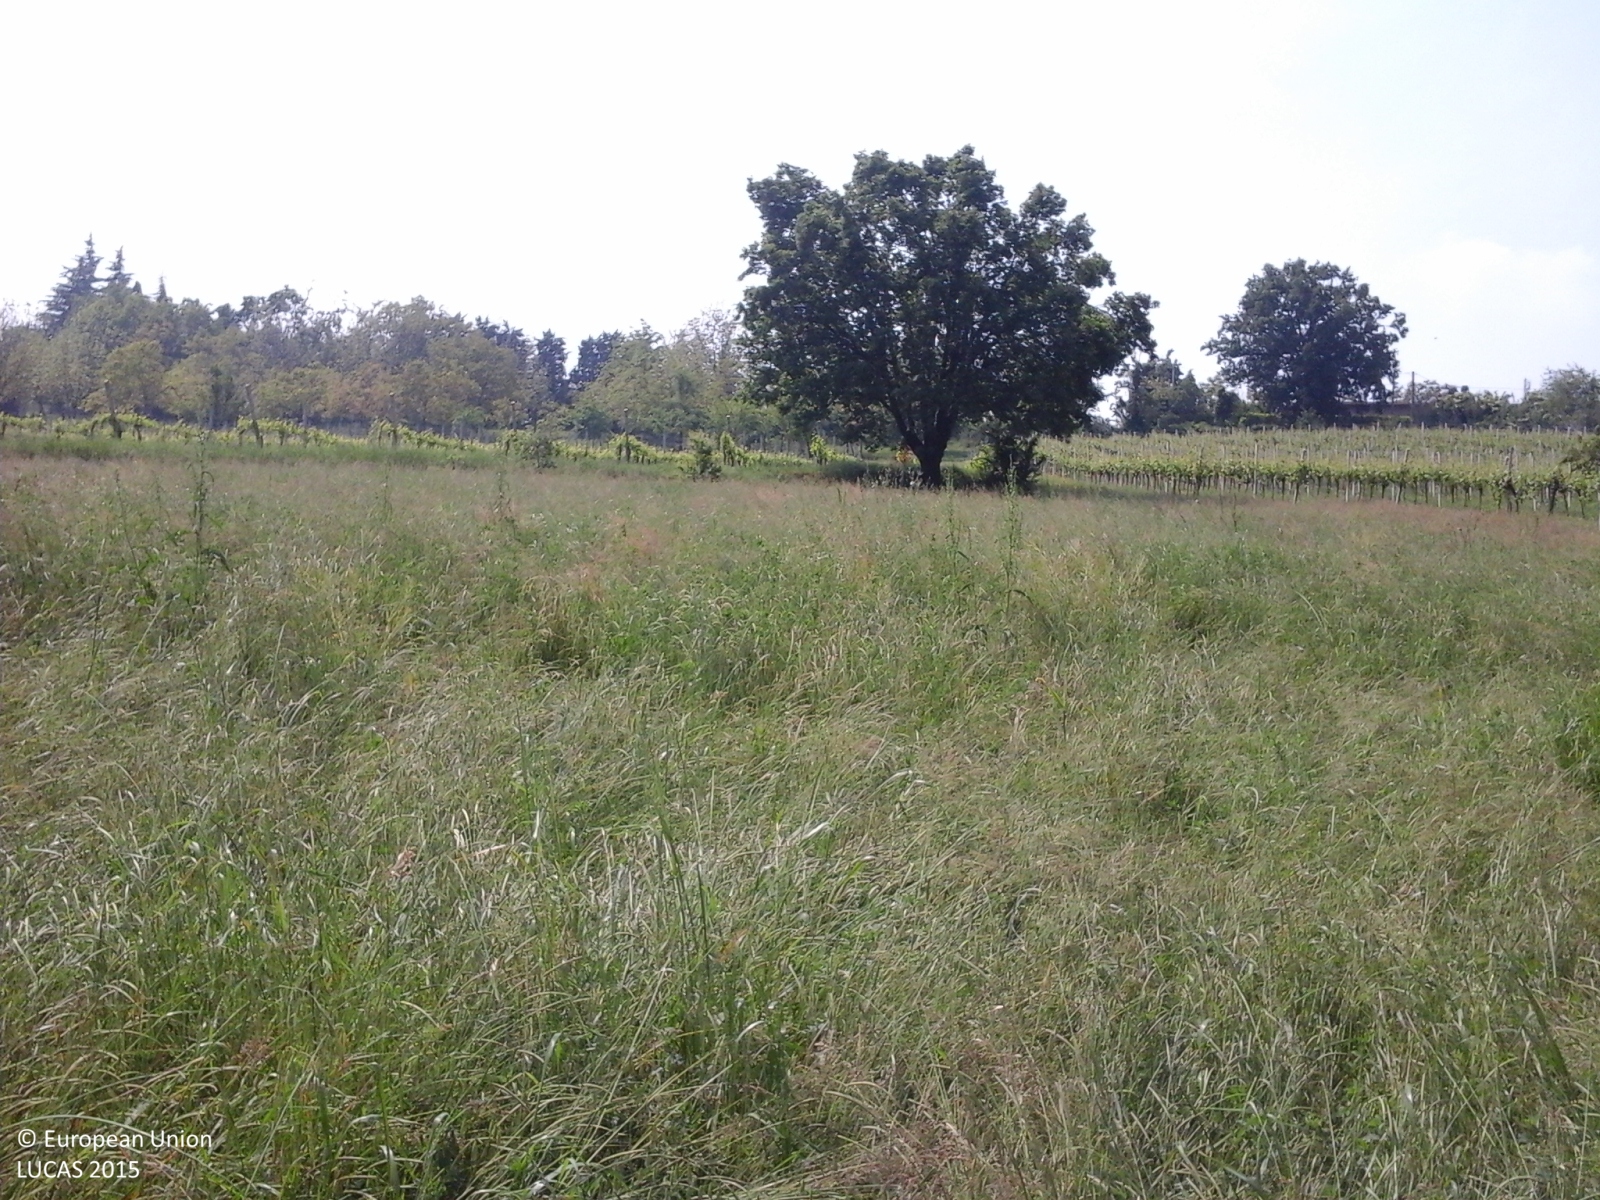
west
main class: Cropland
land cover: Lucerne
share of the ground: > 75 %
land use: Agriculture (excluding fallow land and kitchen gardens)
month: May
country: IT
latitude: 44.4908
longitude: 10.9159
